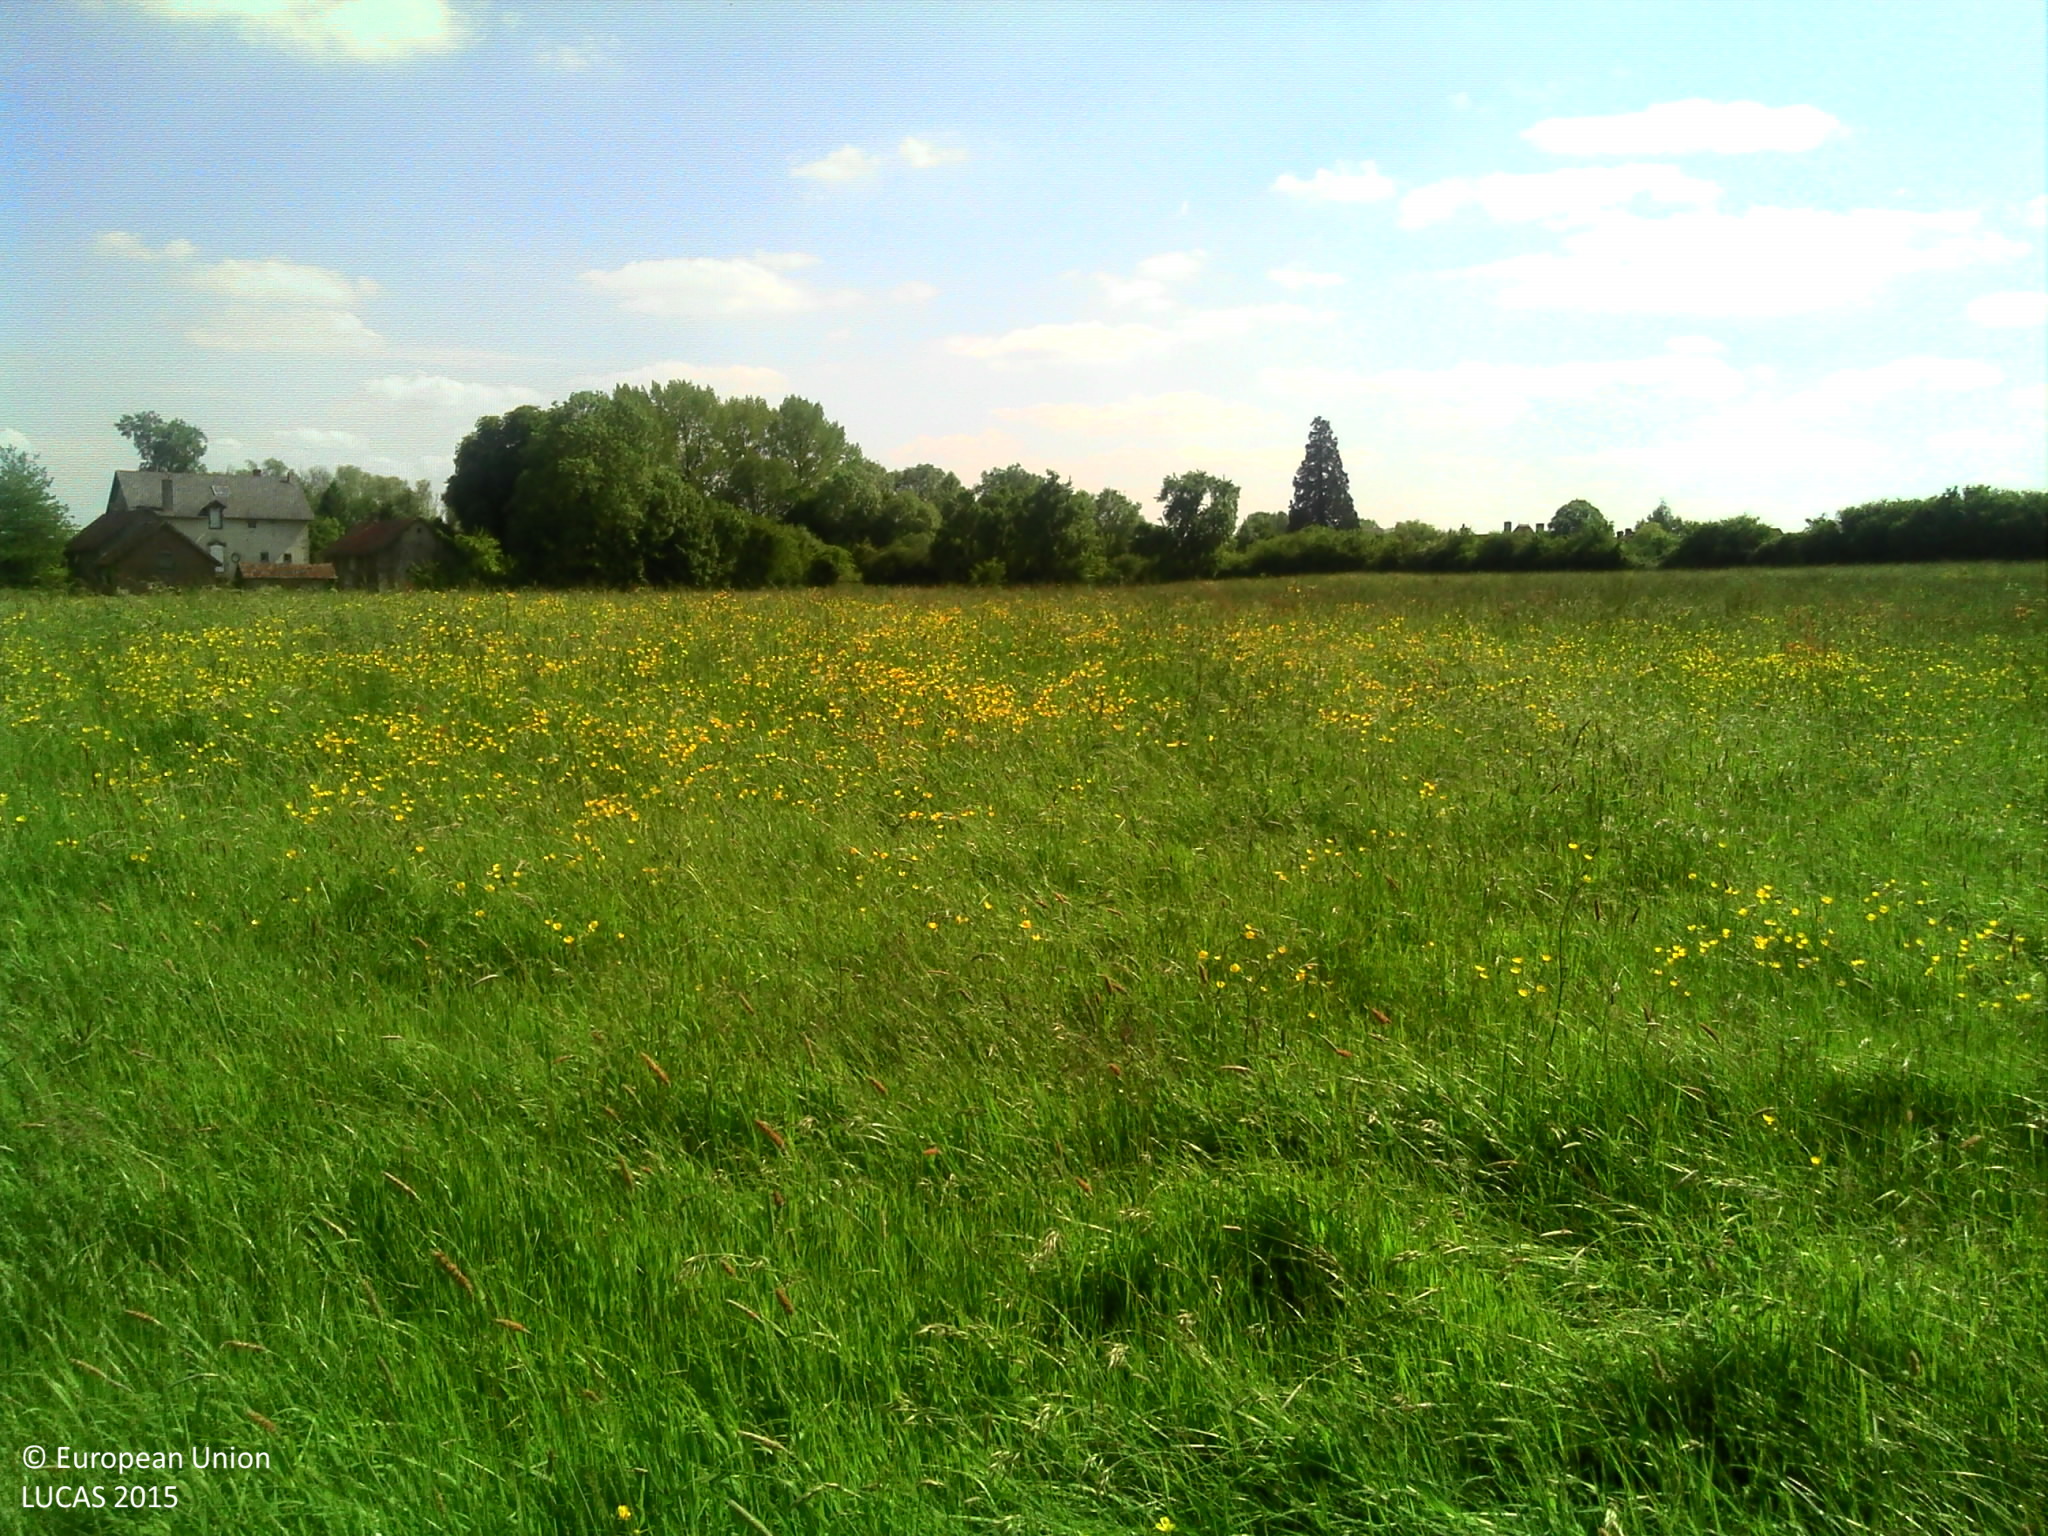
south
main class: Grassland
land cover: Grassland without tree/shrub cover
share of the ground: > 75 %
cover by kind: herbaceous plants 95 %, shrubs 5 %
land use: Agriculture (excluding fallow land and kitchen gardens)
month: May
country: FR
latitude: 48.7167
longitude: -0.1301
